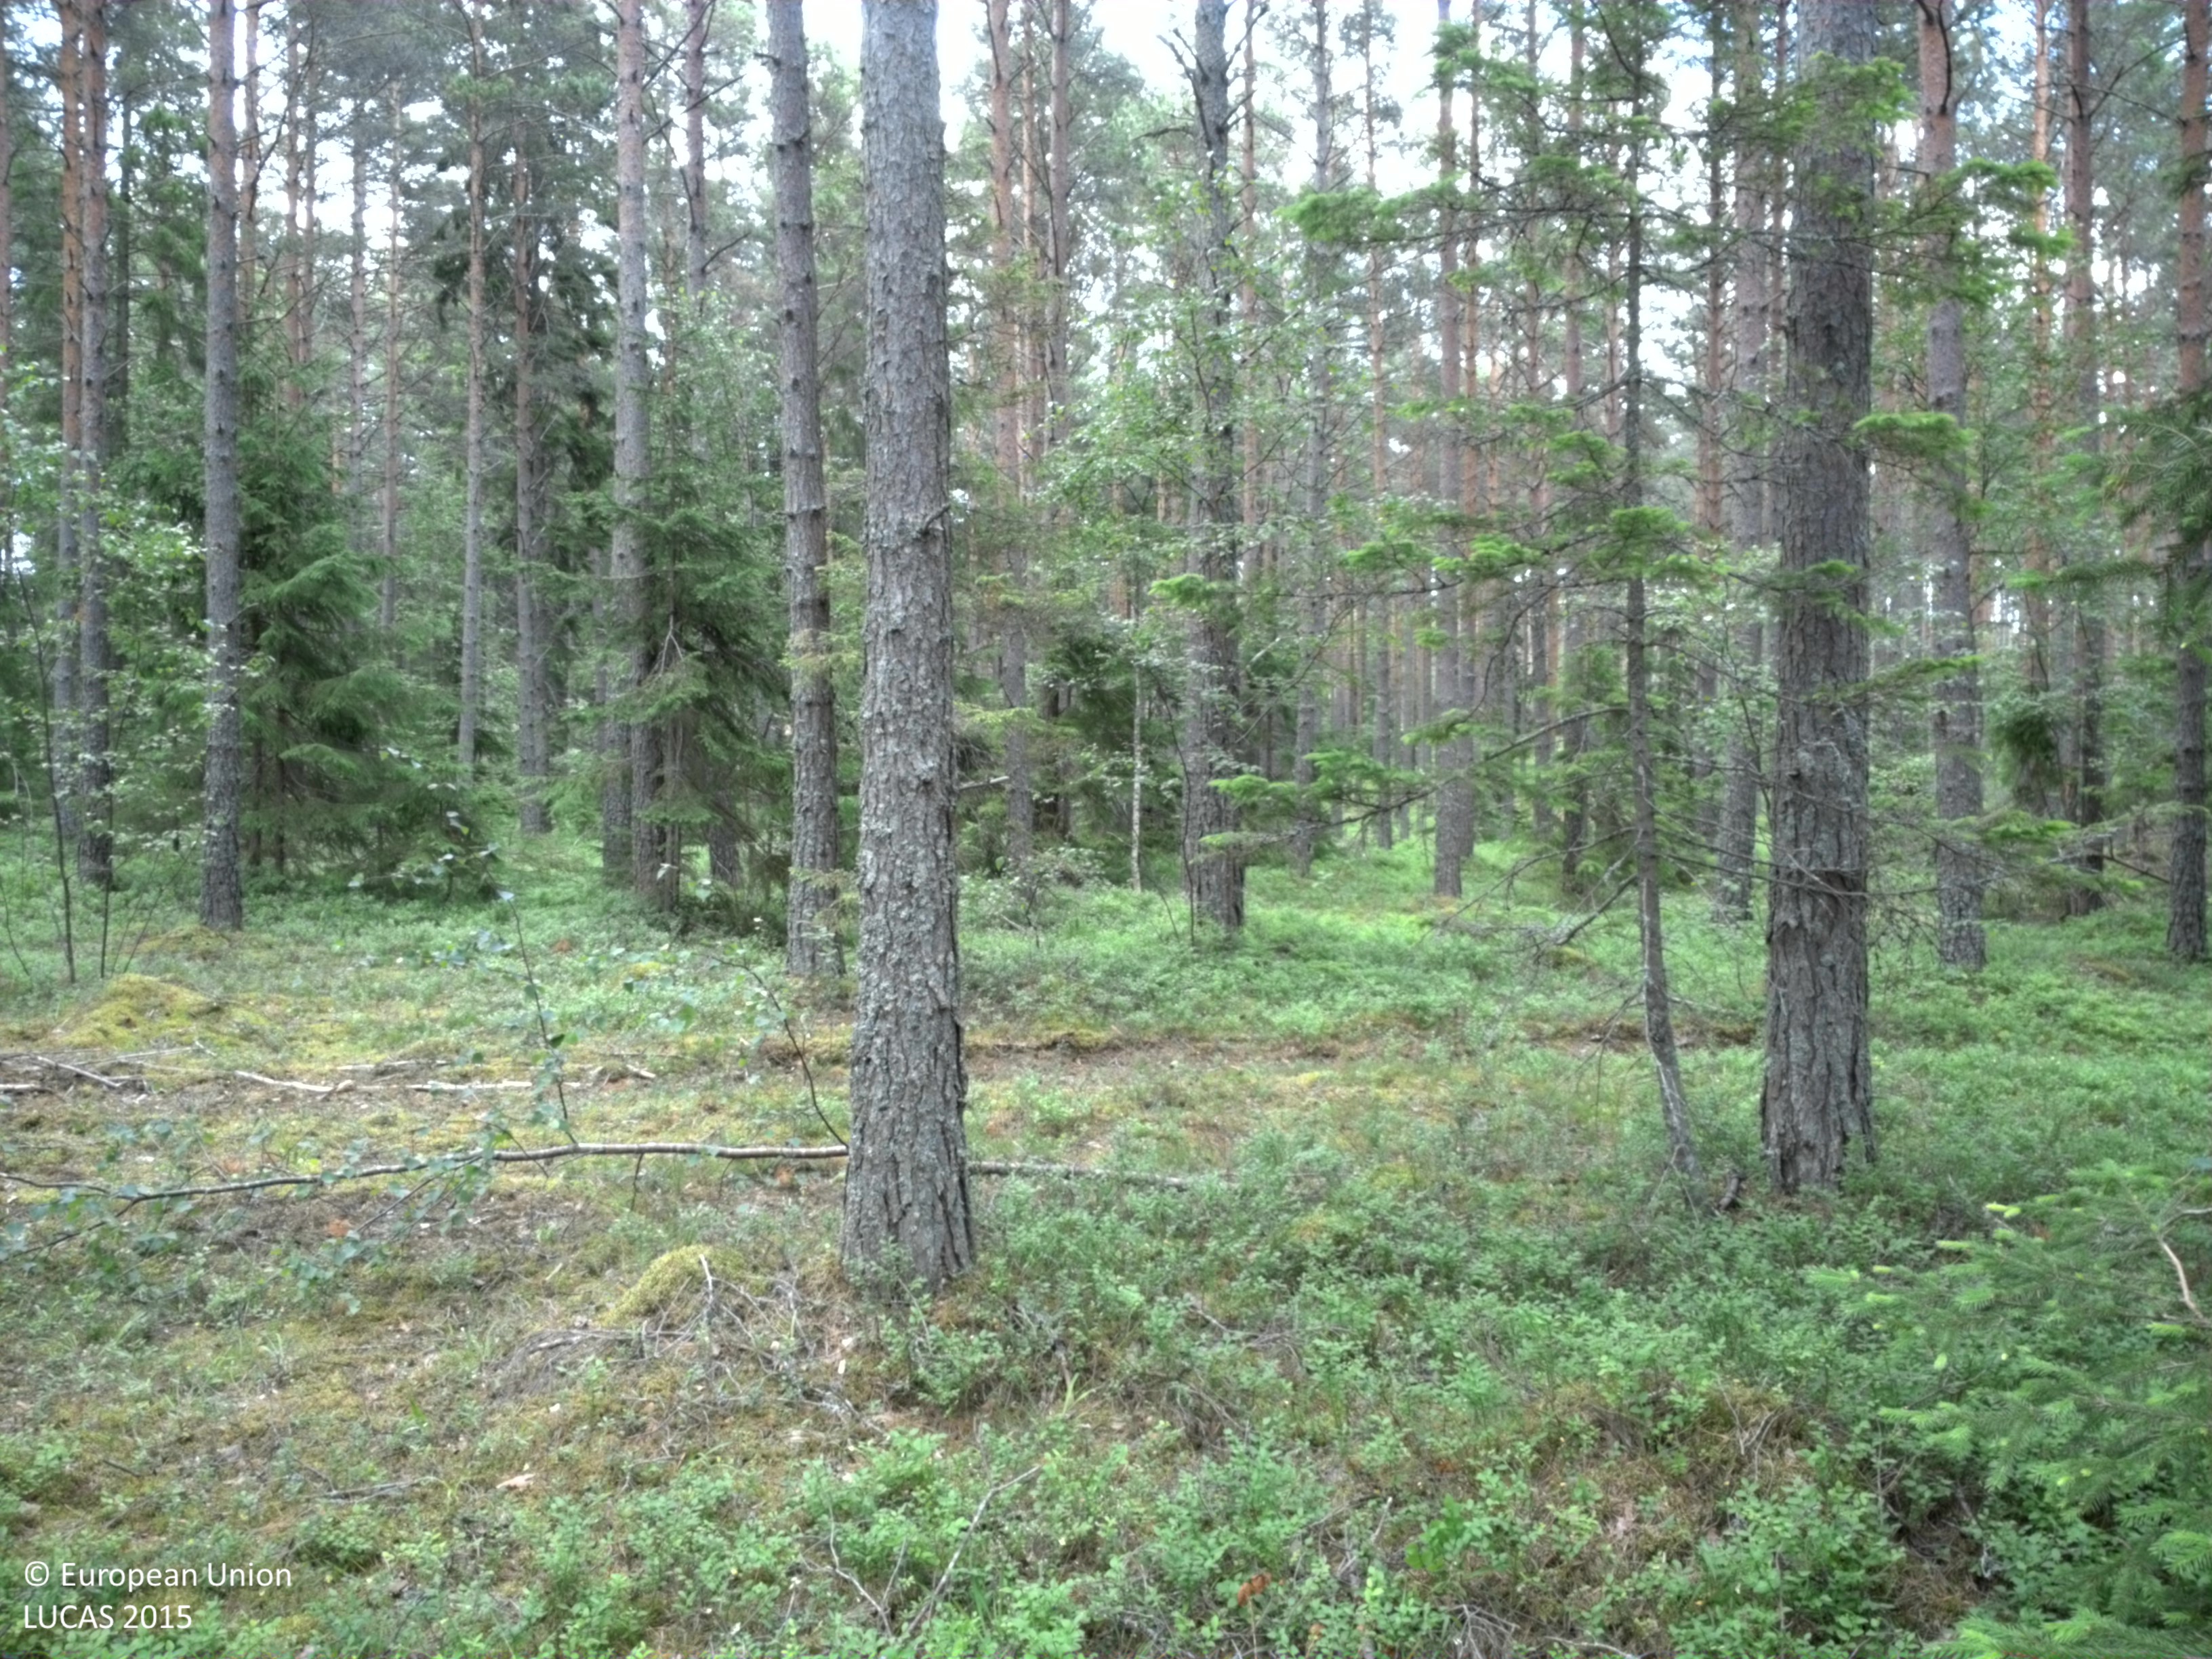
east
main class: Woodland
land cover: Pine dominated mixed woodland
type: boreal forest
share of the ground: > 75 %
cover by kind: coniferous forest trees 60 %, broadleaved forest trees 20 %, herbaceous plants 20 %
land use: Forestry
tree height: > 5 m
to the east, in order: Pine dominated mixed woodland; Grassland with sparse tree/shrub cover
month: July
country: SE
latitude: 59.6165
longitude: 18.4900
